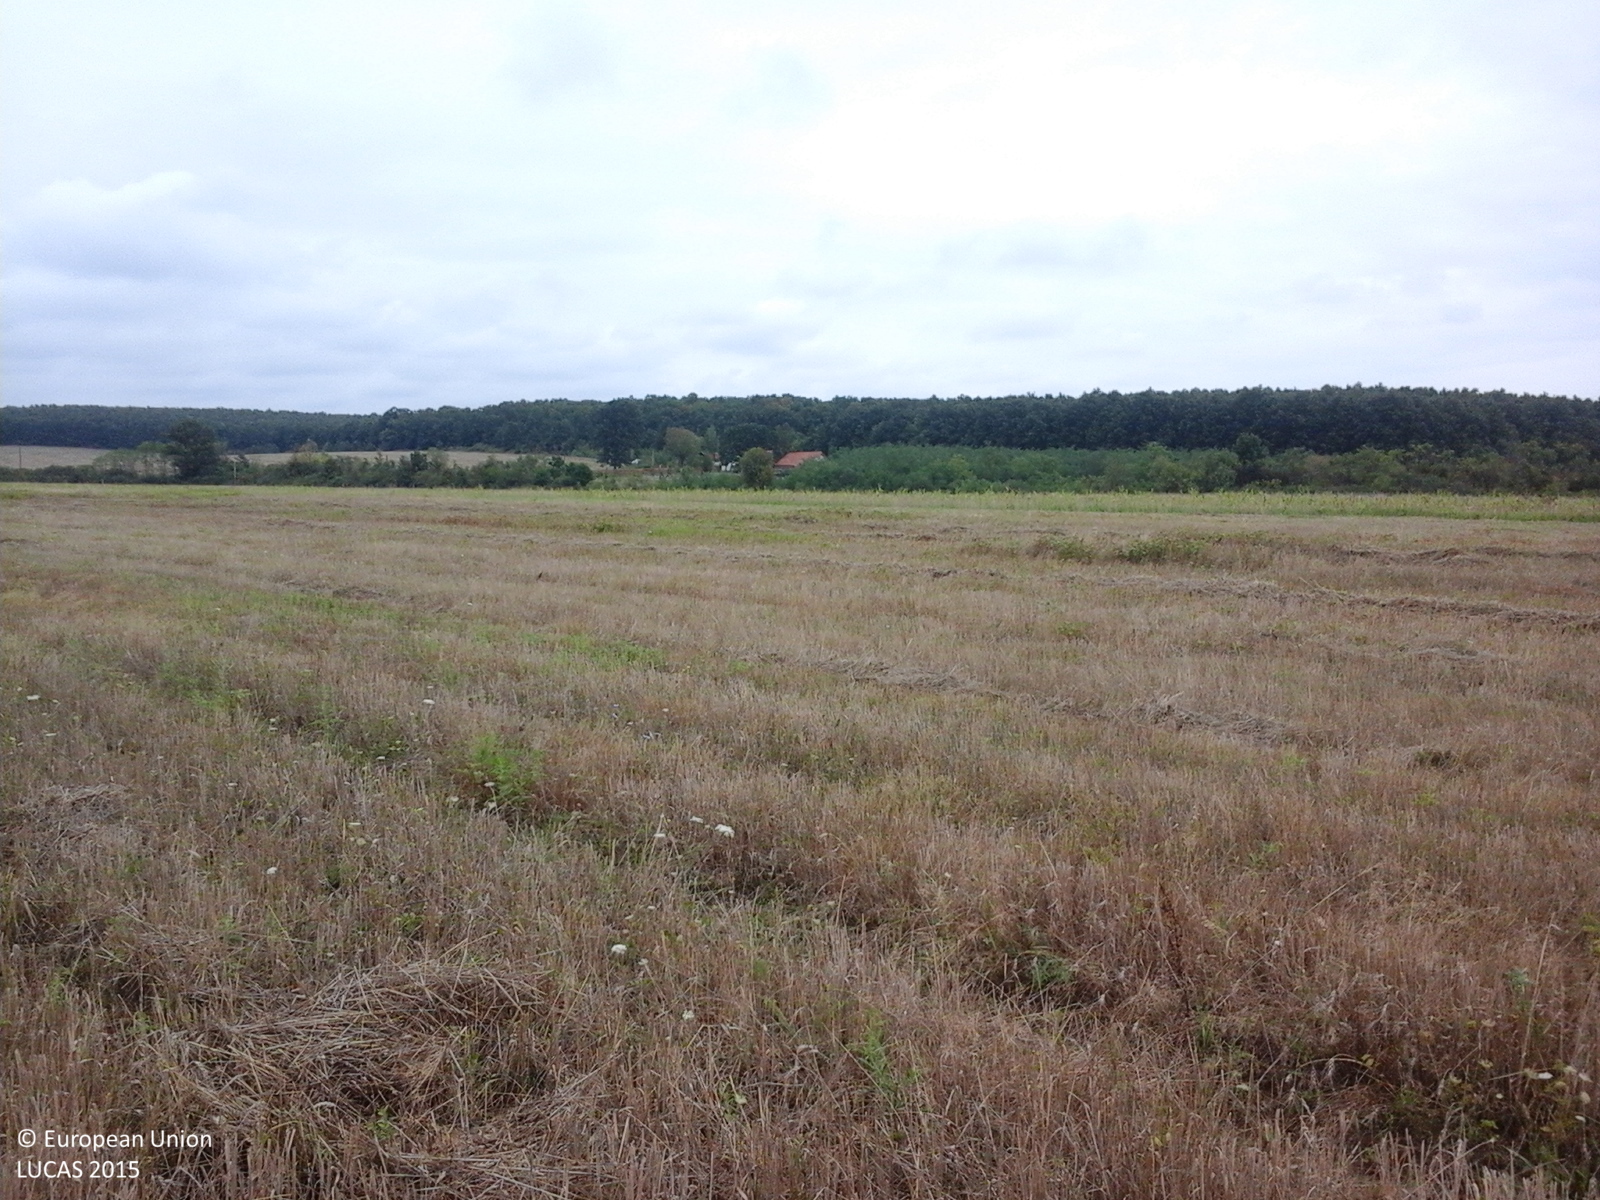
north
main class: Cropland
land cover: Common wheat
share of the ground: > 75 %
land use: Agriculture (excluding fallow land and kitchen gardens)
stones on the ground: < 10 %
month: August
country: RO
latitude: 45.8269
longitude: 21.7641
